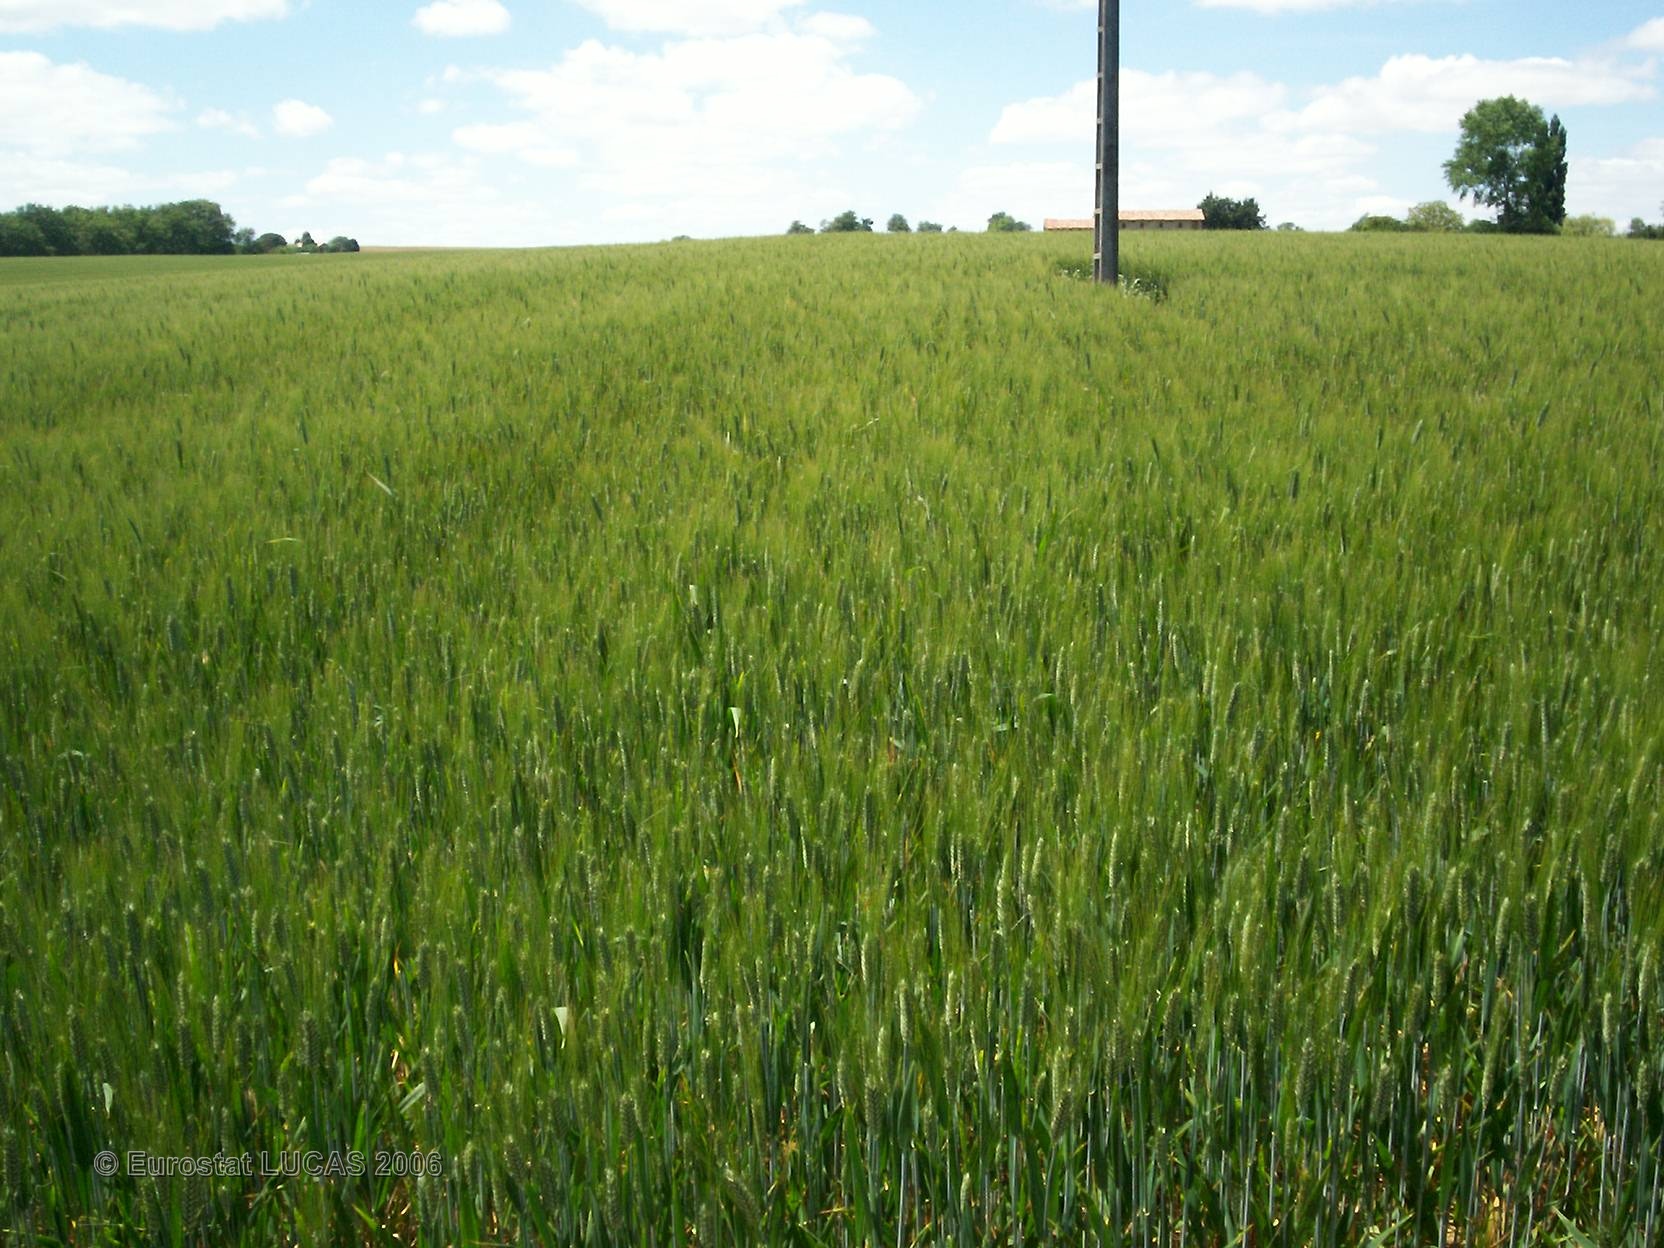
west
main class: Cropland
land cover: Barley
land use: Agriculture (excluding fallow land and kitchen gardens)
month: May
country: FR
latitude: 43.7186
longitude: 0.9508
